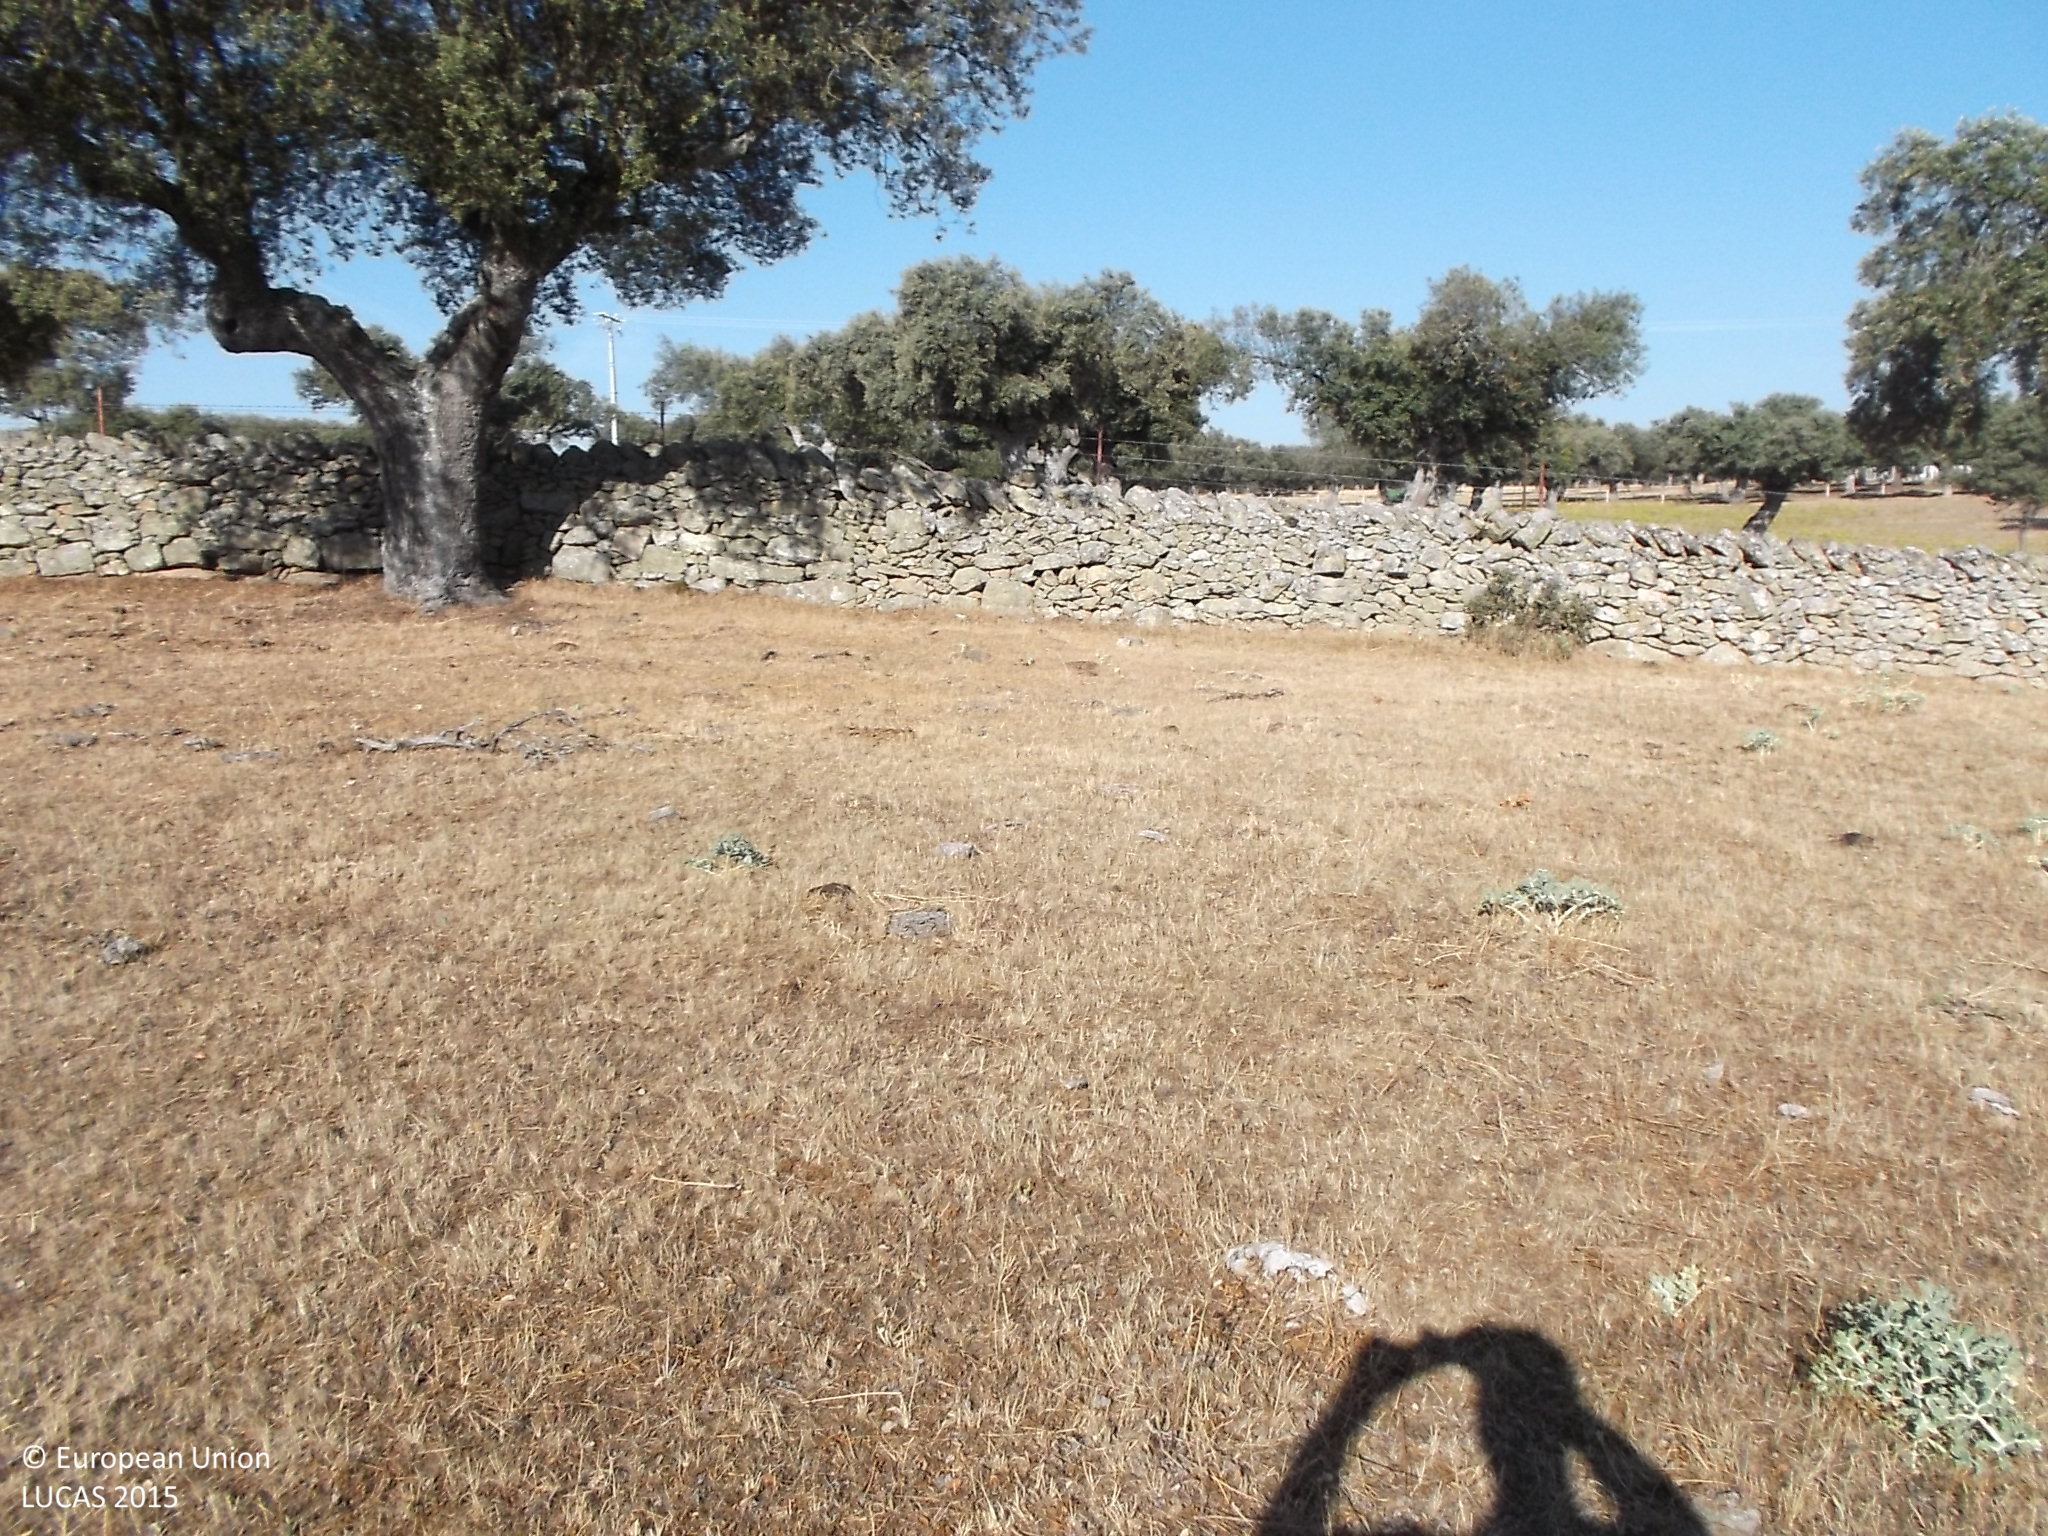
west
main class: Grassland
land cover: Grassland with sparse tree/shrub cover
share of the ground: > 75 %
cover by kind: herbaceous plants 90 %, broadleaved forest trees 5 %, shrubs 5 %
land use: Agriculture (excluding fallow land and kitchen gardens)
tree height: < 5 m
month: July
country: ES
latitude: 41.1037
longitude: -5.9574
